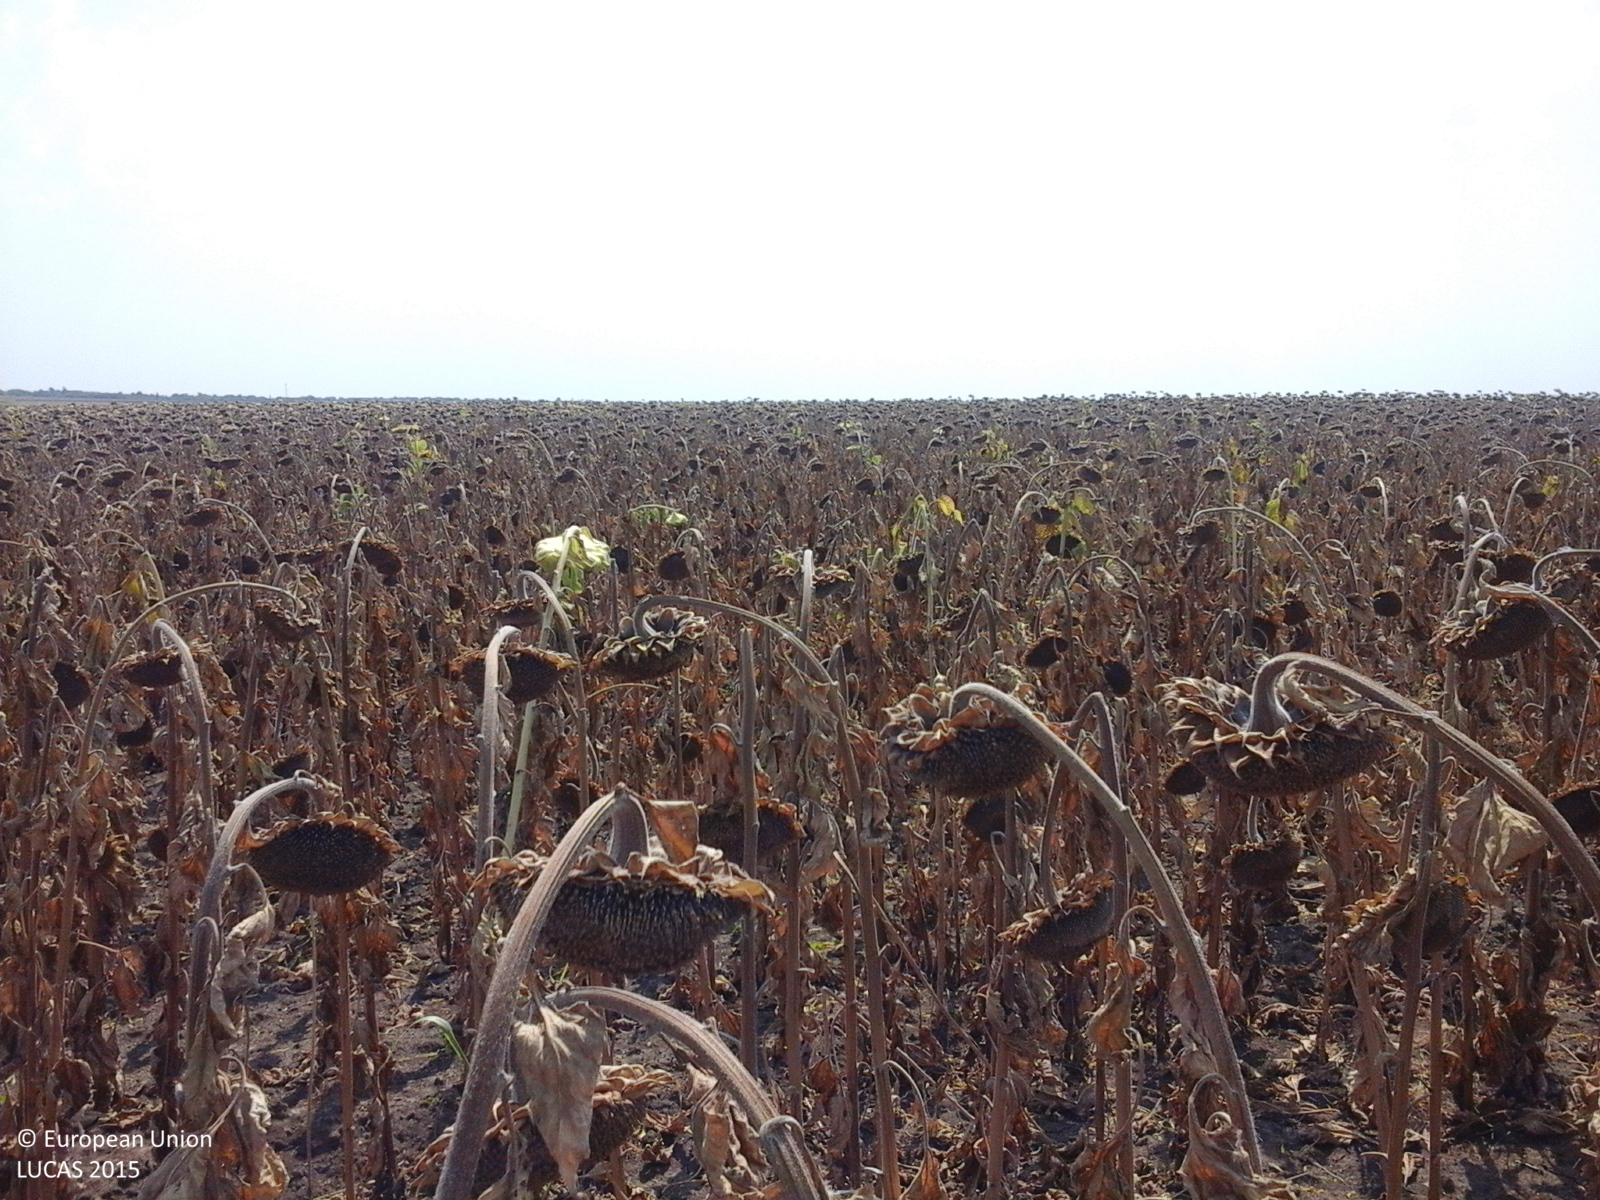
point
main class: Cropland
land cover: Sunflower
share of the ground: > 75 %
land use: Agriculture (excluding fallow land and kitchen gardens)
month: August
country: RO
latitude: 44.1523
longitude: 23.2622
